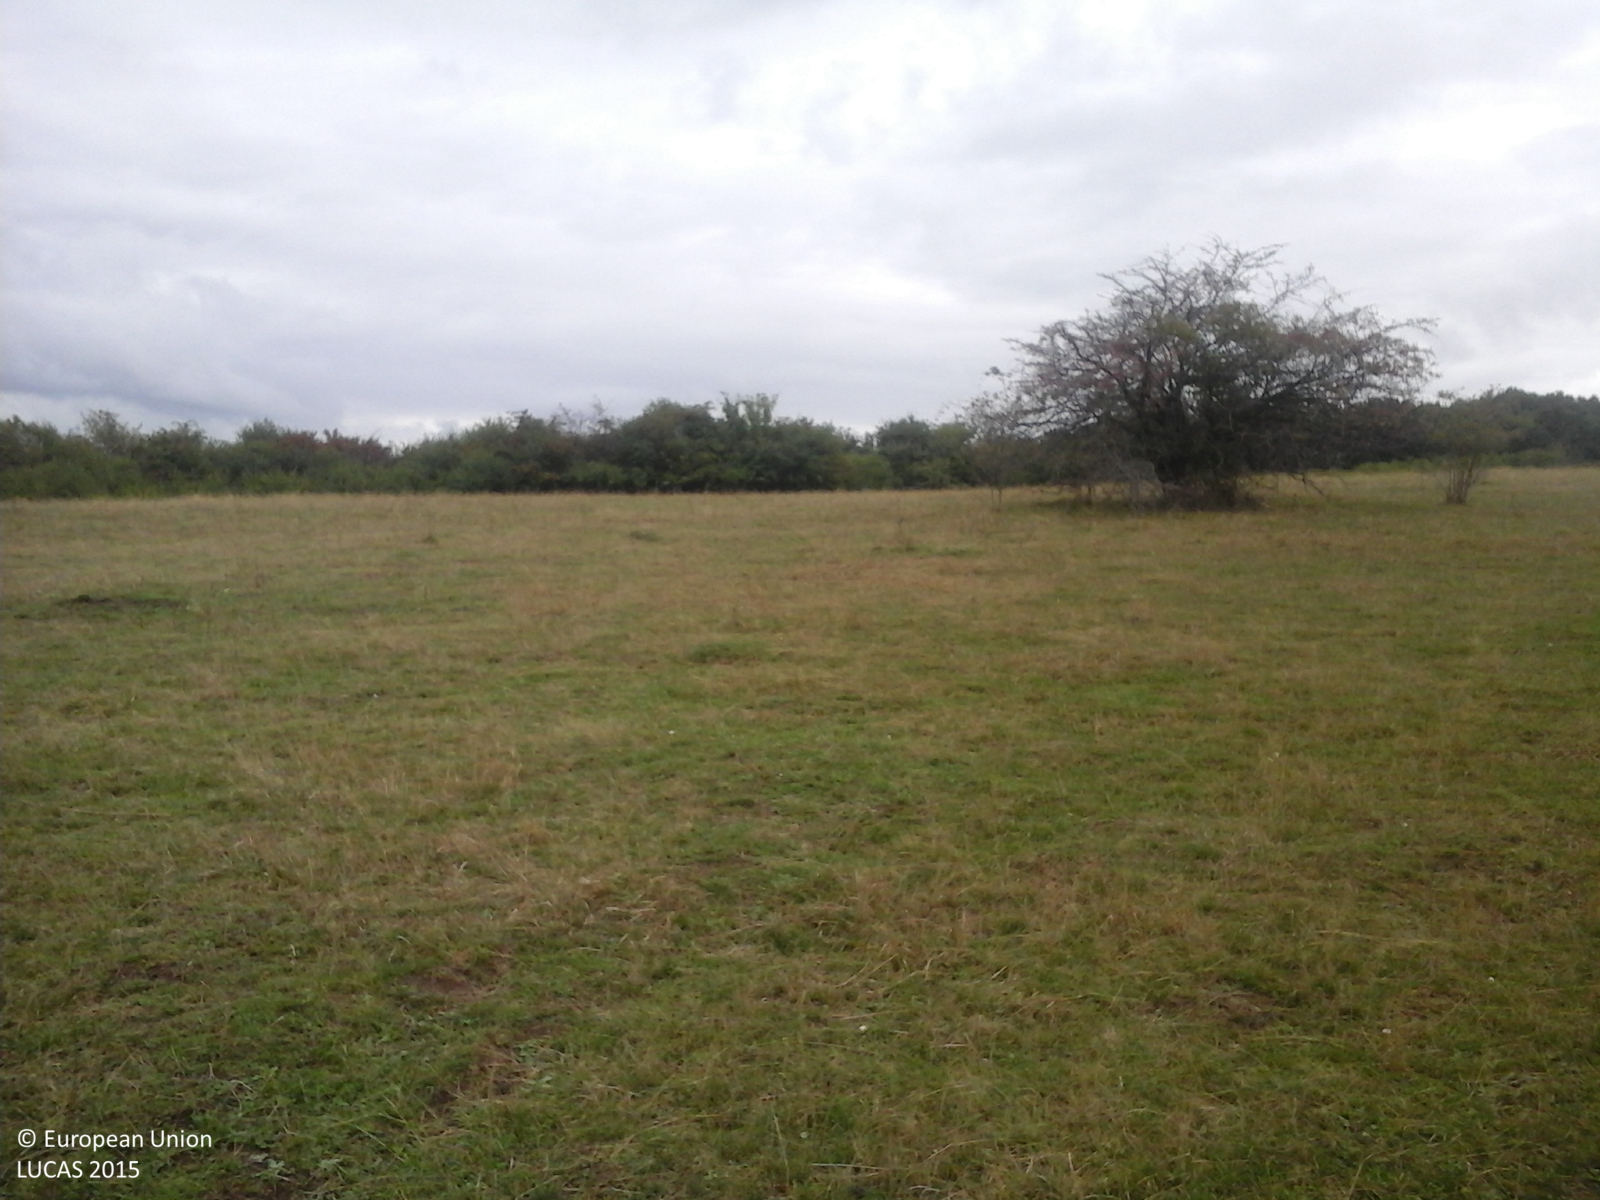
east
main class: Grassland
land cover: Grassland with sparse tree/shrub cover
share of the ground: > 75 %
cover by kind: herbaceous plants 85 %, shrubs 10 %, broadleaved forest trees 5 %
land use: Agriculture (excluding fallow land and kitchen gardens)
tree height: < 5 m
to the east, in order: Grassland with sparse tree/shrub cover; Single bushes/trees; Grassland with sparse tree/shrub cover; Tracks; Grassland with sparse tree/shrub cover; Shrubland without tree cover; Grassland with sparse tree/shrub cover; Shrubland without tree cover; Tracks; Shrubland without tree cover; Other fruit trees and berries; Broadleaved woodland
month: September
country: RO
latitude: 45.8443
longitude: 23.7293
